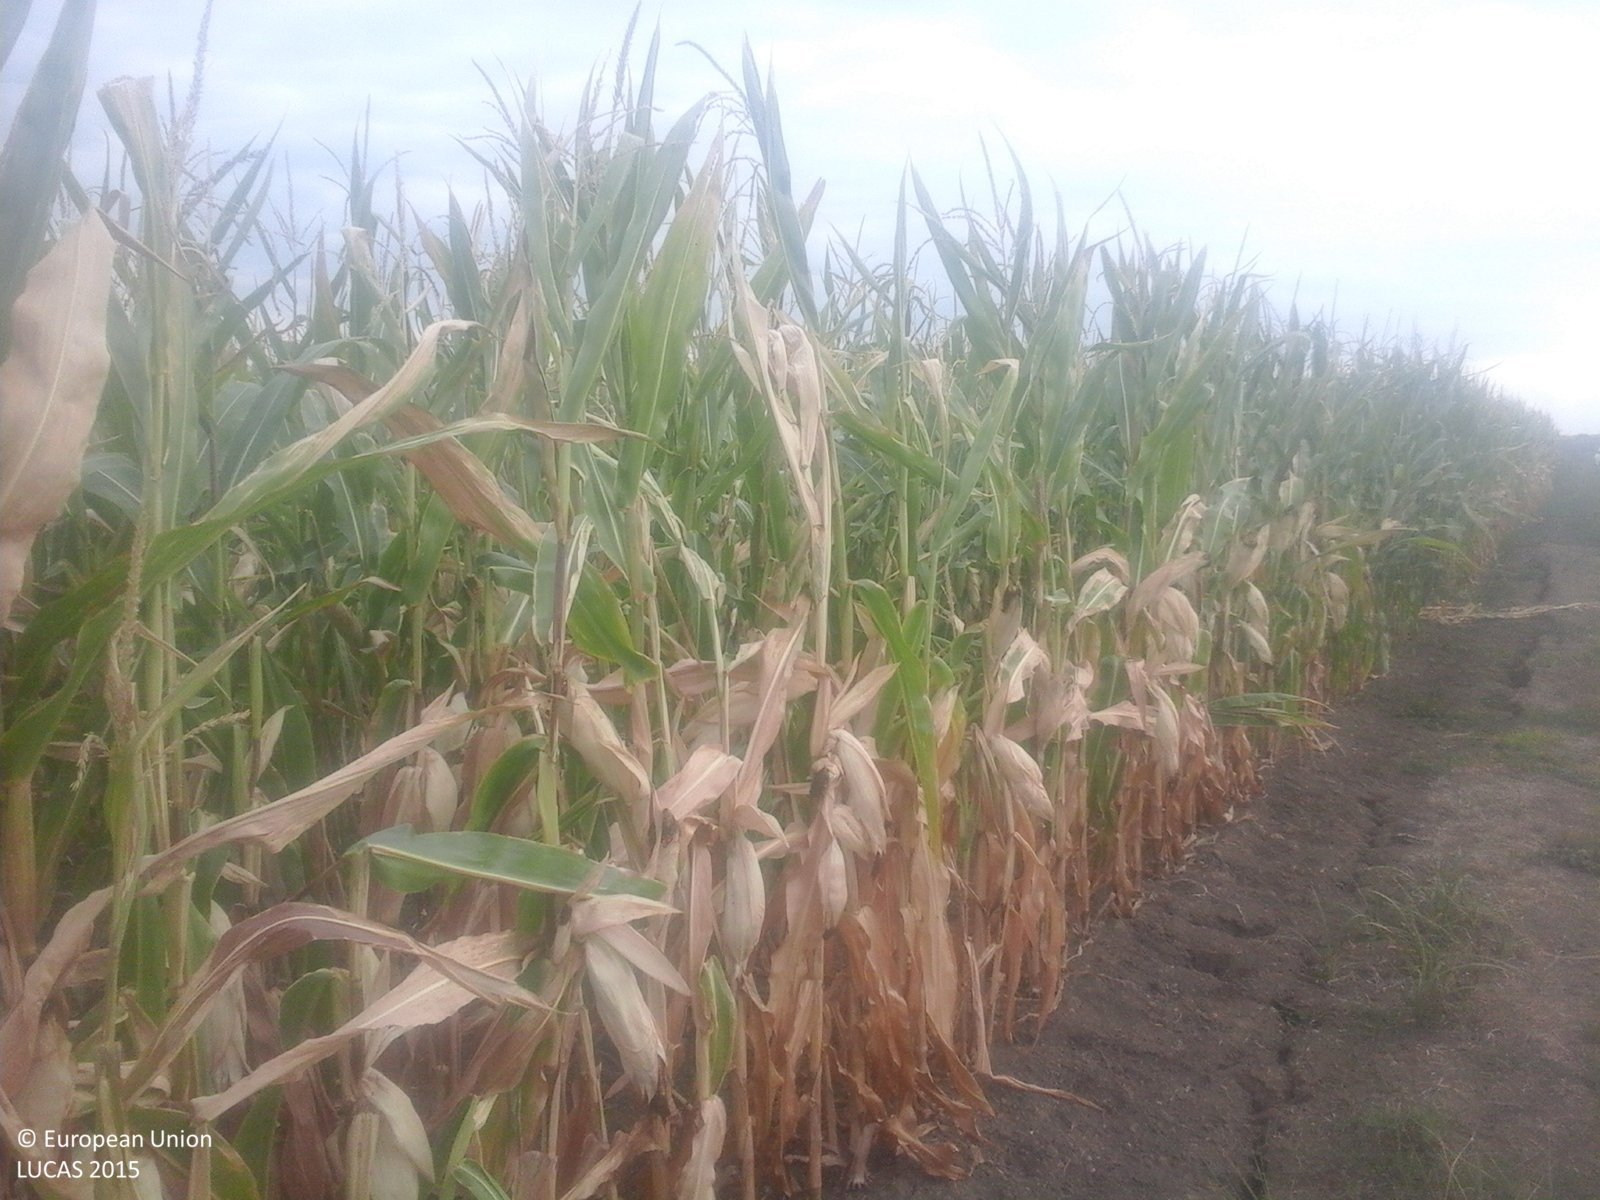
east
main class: Cropland
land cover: Maize
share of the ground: > 75 %
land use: Agriculture (excluding fallow land and kitchen gardens)
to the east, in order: Maize; Ditches and canals; Single bushes/trees; Shruby margins; Tracks; Spontaneously vegetated surfaces
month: September
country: RO
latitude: 47.7685
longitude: 22.6162
